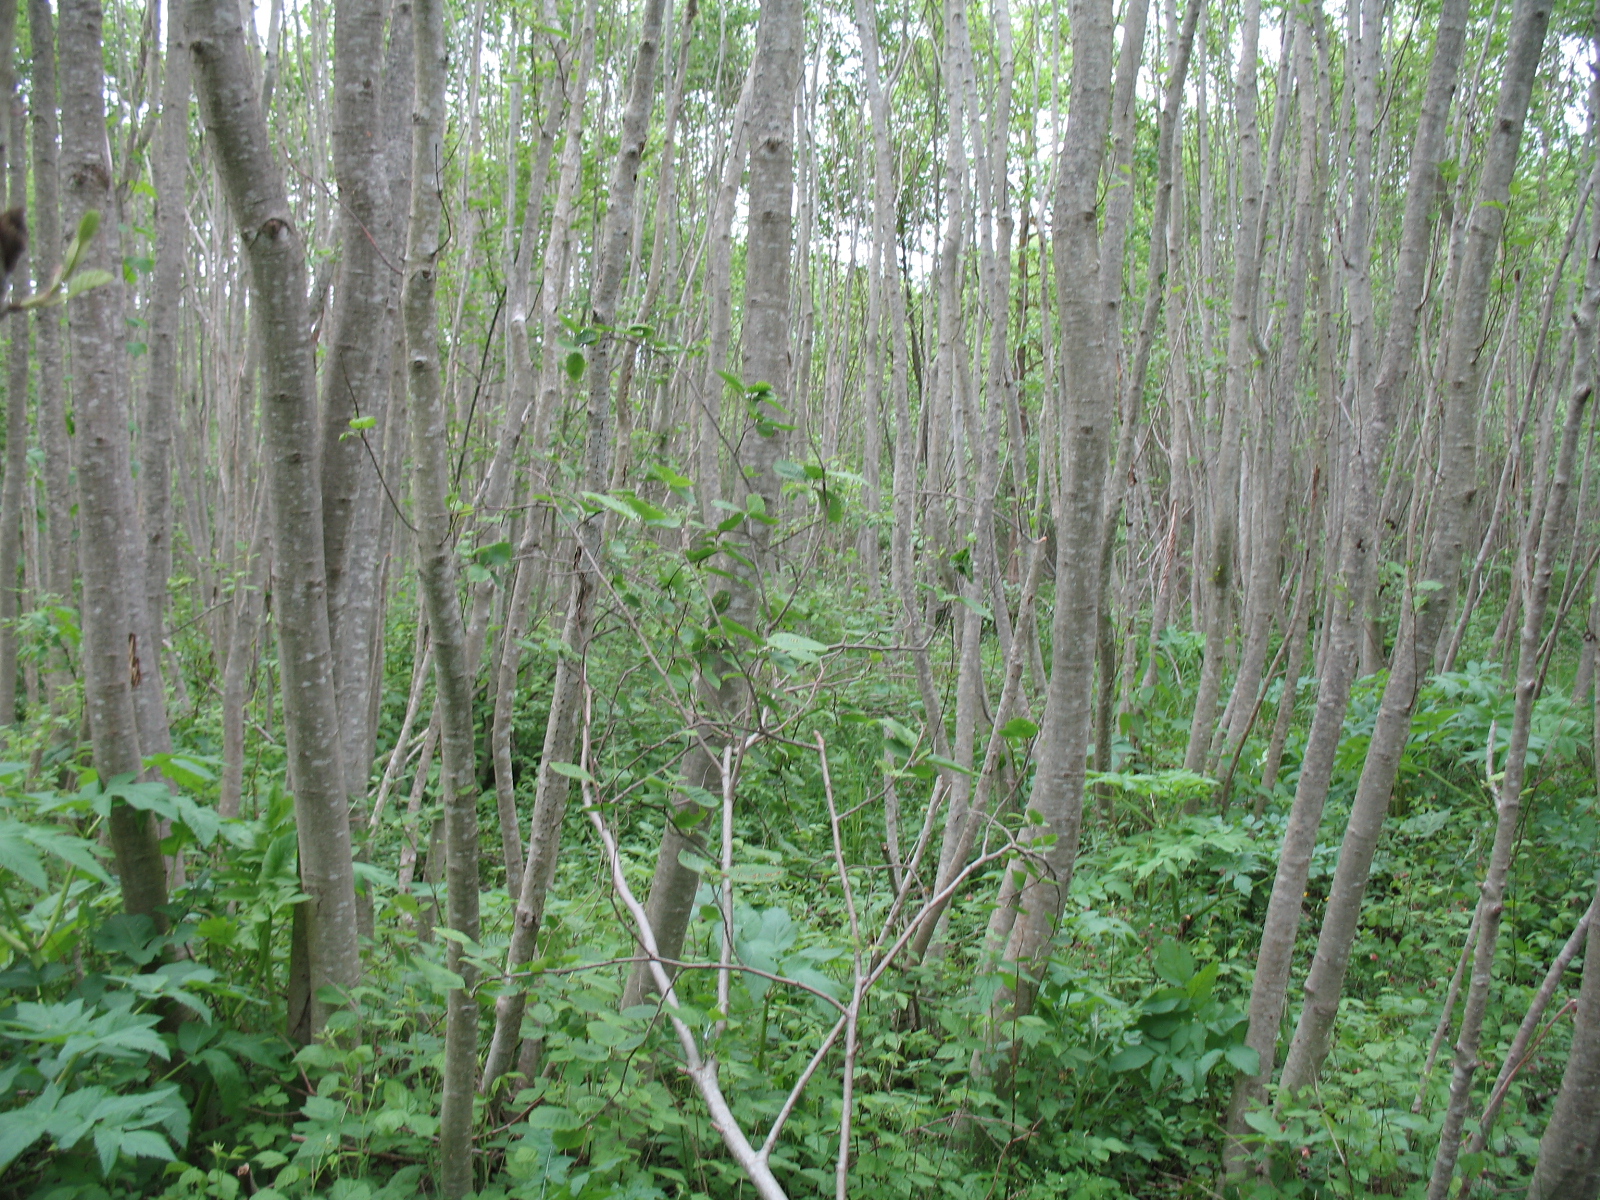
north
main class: Woodland
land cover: Broadleaved woodland
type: mire and swamp forests
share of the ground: > 75 %
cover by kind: broadleaved forest trees 95 %, herbaceous plants 5 %
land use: Forestry
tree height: > 5 m
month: May
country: LV
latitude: 56.7451
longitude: 23.5315
